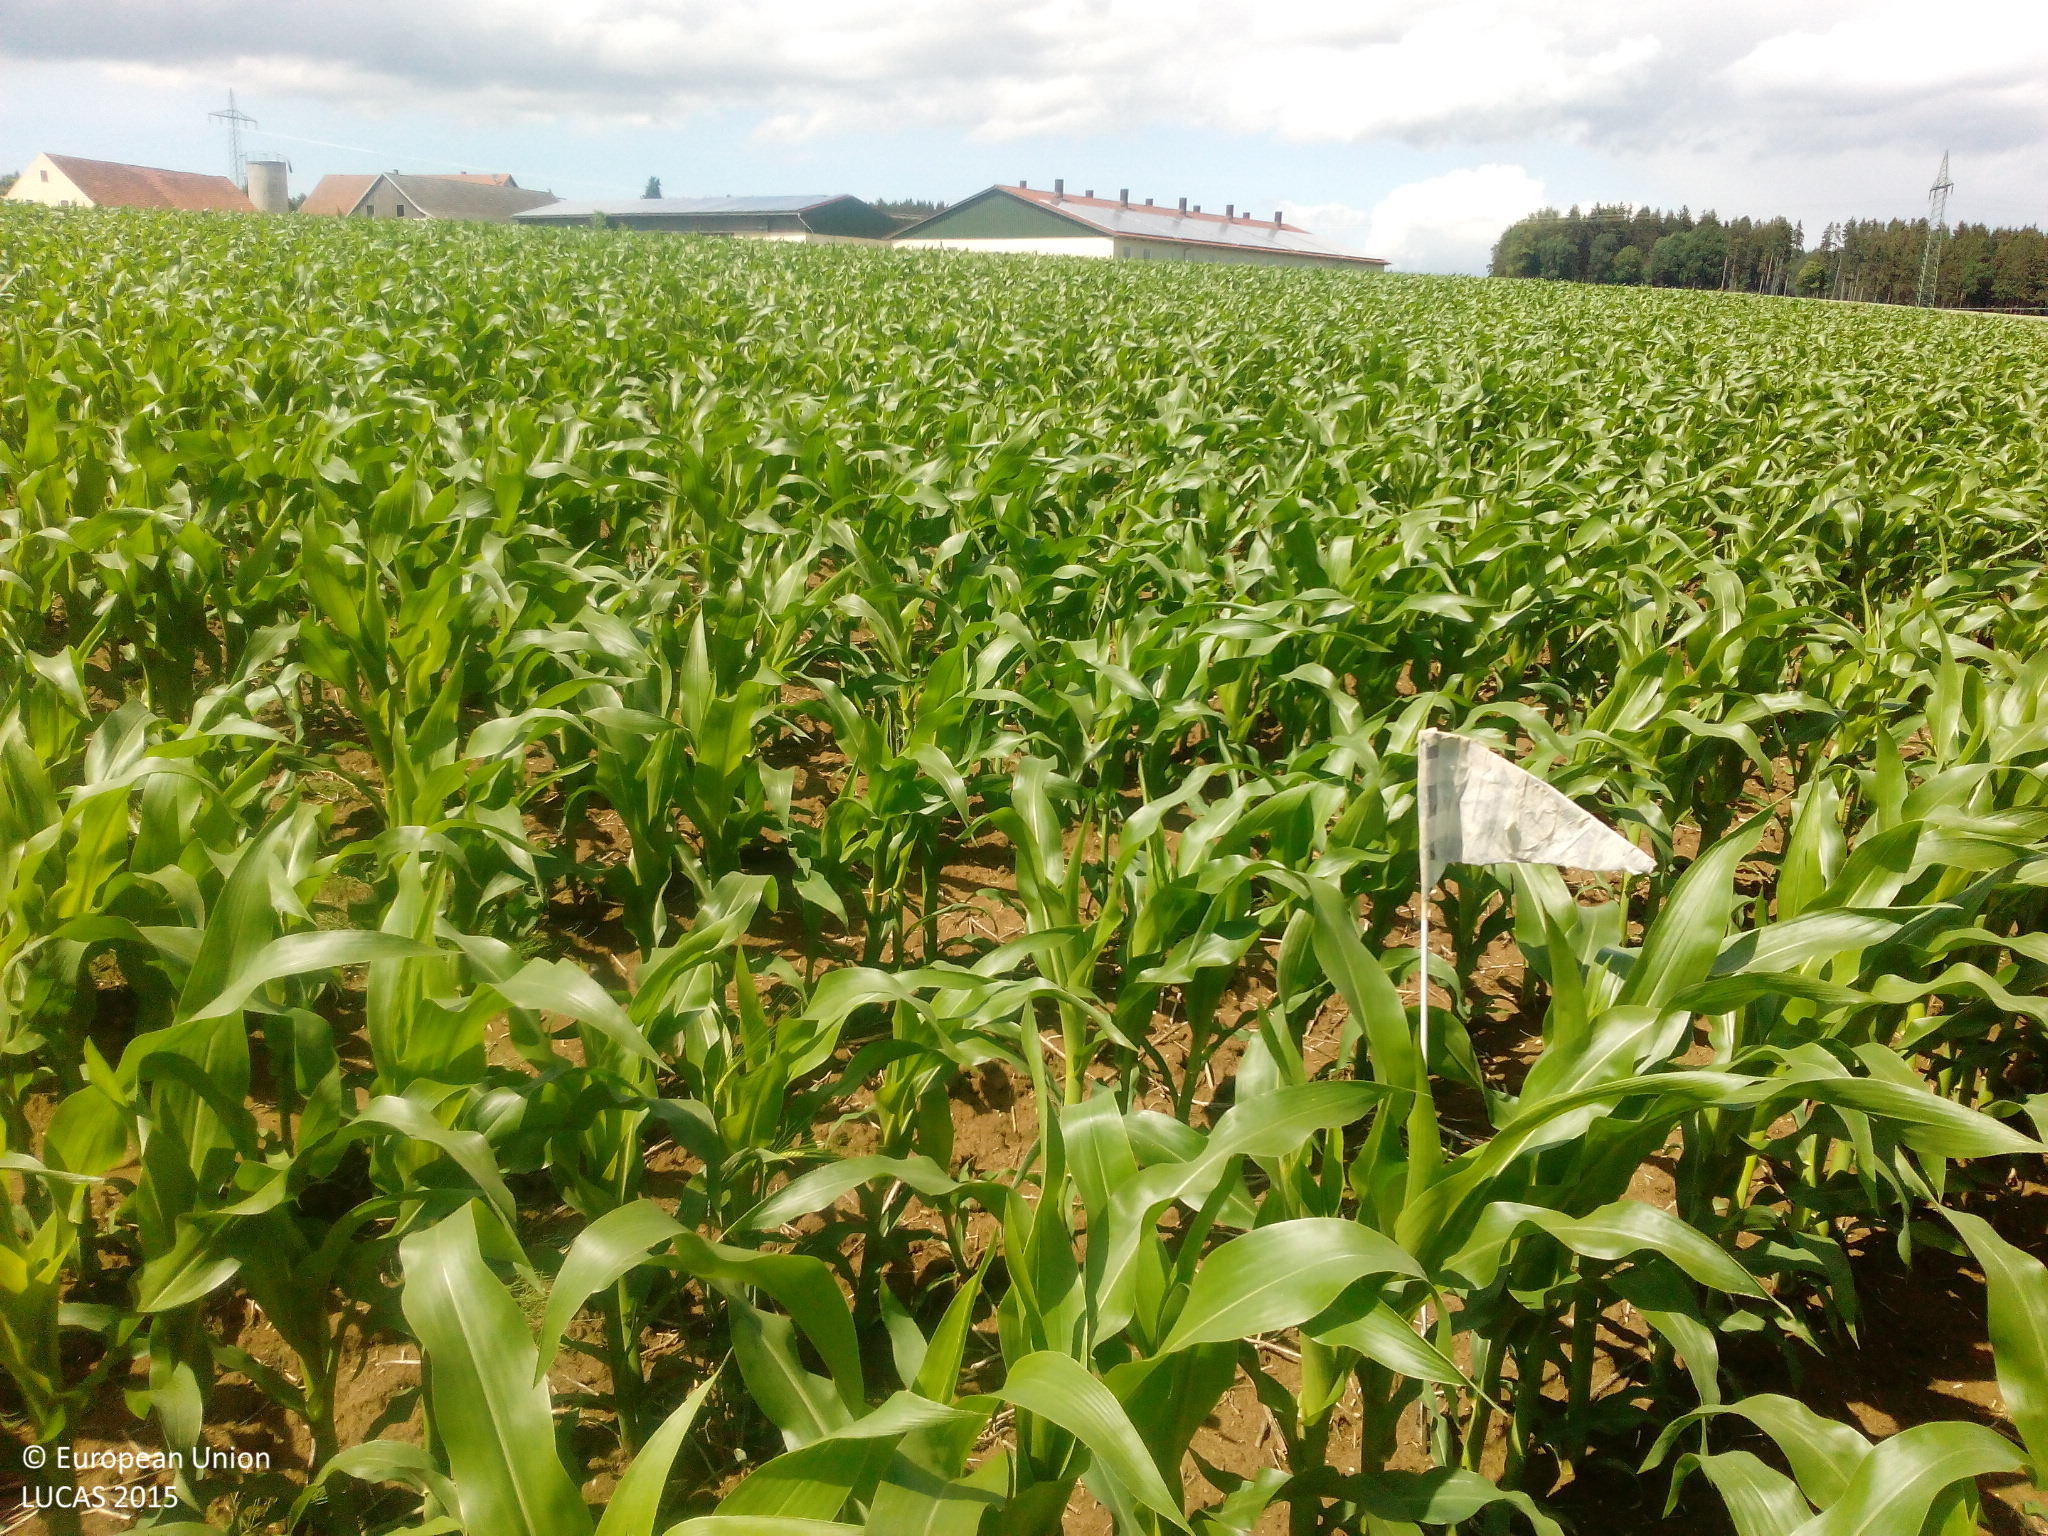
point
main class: Cropland
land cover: Maize
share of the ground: 25 - 50 %
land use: Agriculture (excluding fallow land and kitchen gardens)
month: June
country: DE
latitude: 48.6029
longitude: 11.9114
